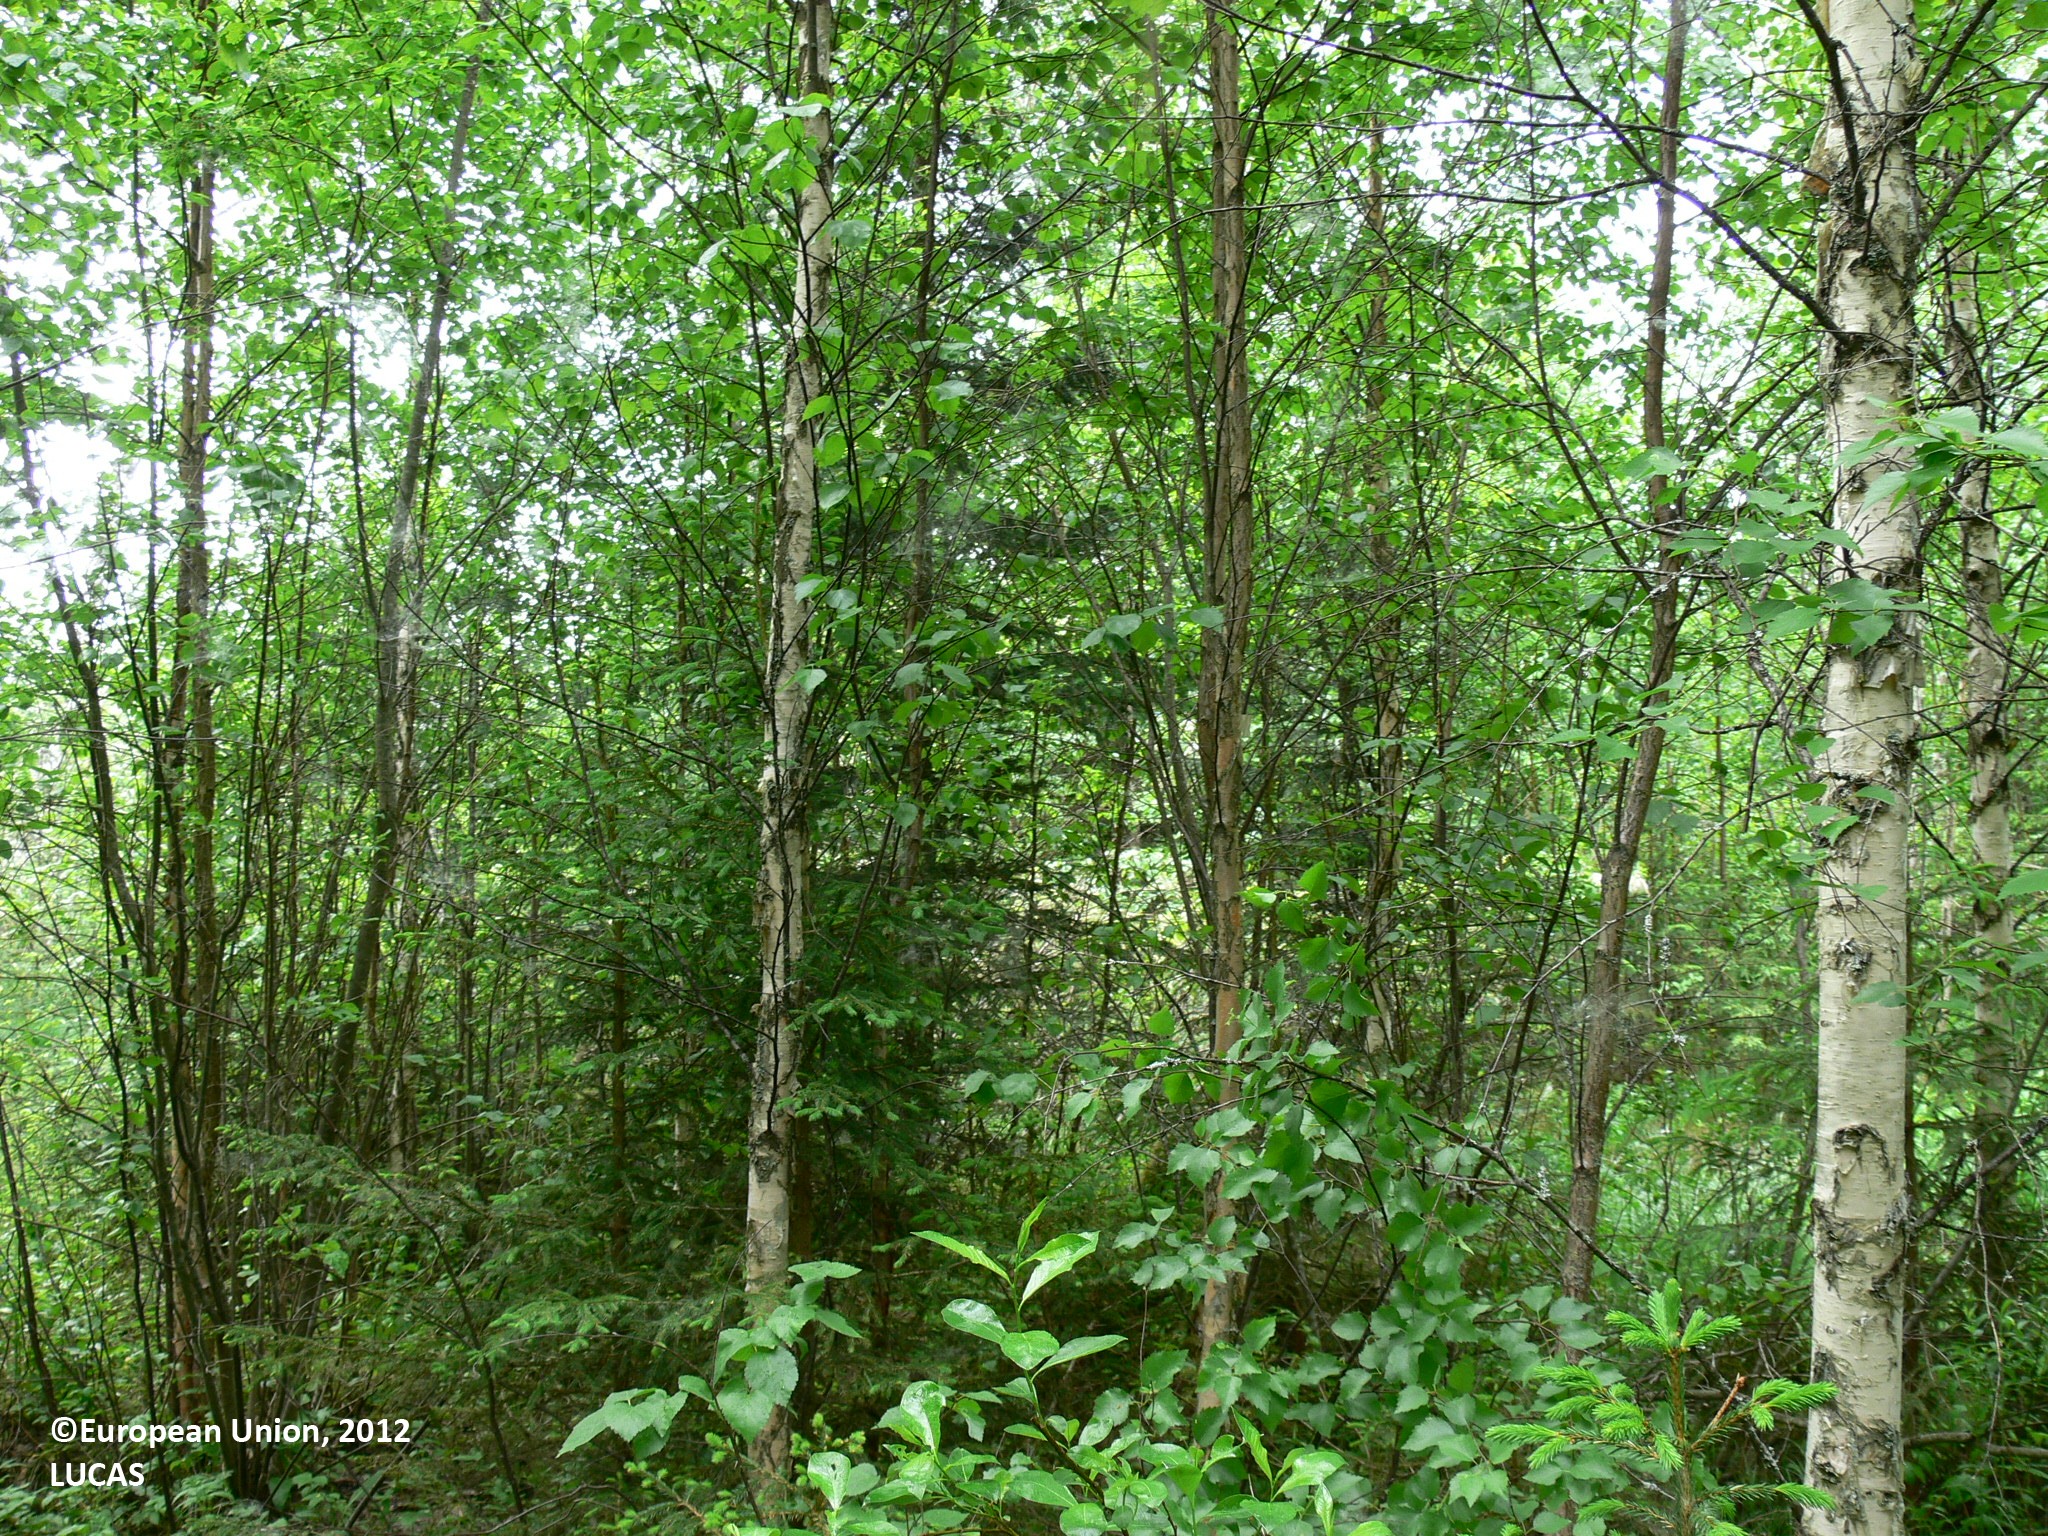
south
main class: Woodland
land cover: Spruce dominated mixed woodland
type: boreal forest
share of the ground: 50 - 75 %
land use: Forestry
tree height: > 5 m
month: June
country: FI
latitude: 62.7815
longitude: 29.8684
